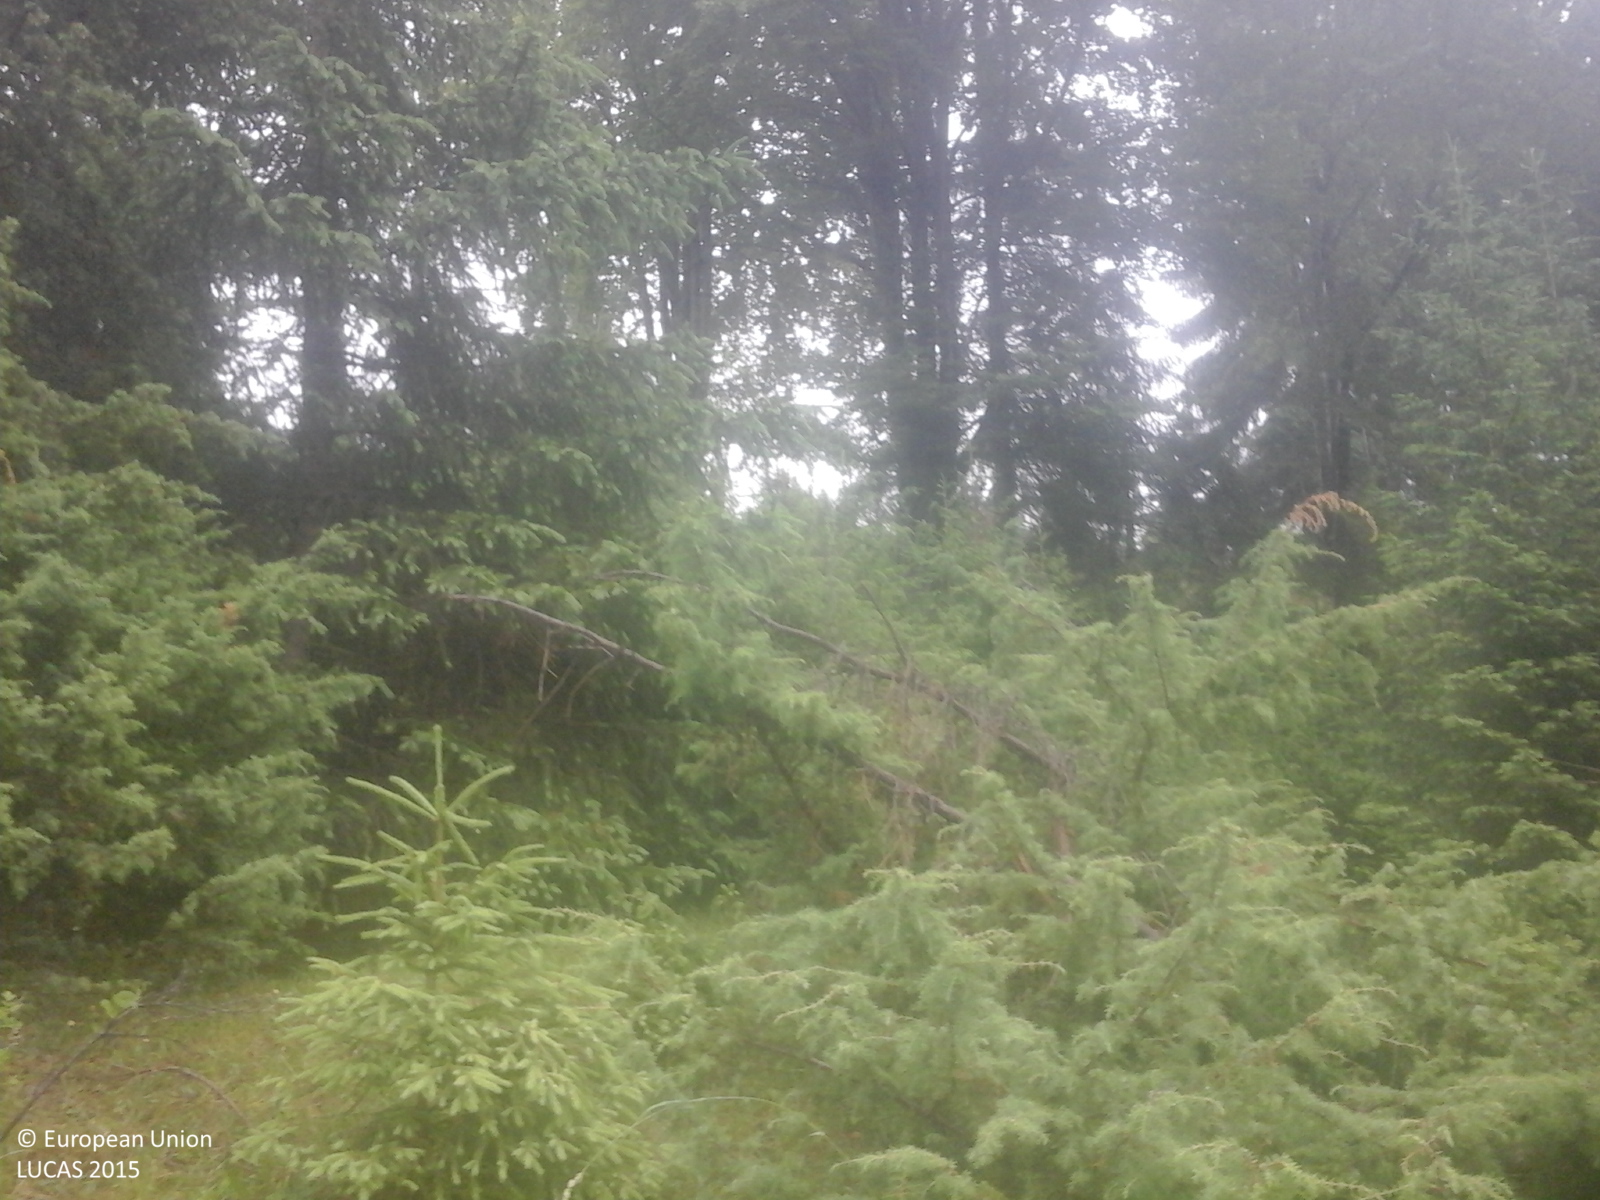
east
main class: Woodland
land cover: Spruce dominated coniferous woodland
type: alpine coniferous forest
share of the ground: > 75 %
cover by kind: coniferous forest trees 80 %, broadleaved forest trees 20 %
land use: Forestry
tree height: > 5 m
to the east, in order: Spruce dominated coniferous woodland; Shrubland with sparse tree cover; Spruce dominated coniferous woodland
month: June
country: RO
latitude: 47.4322
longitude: 25.8621
